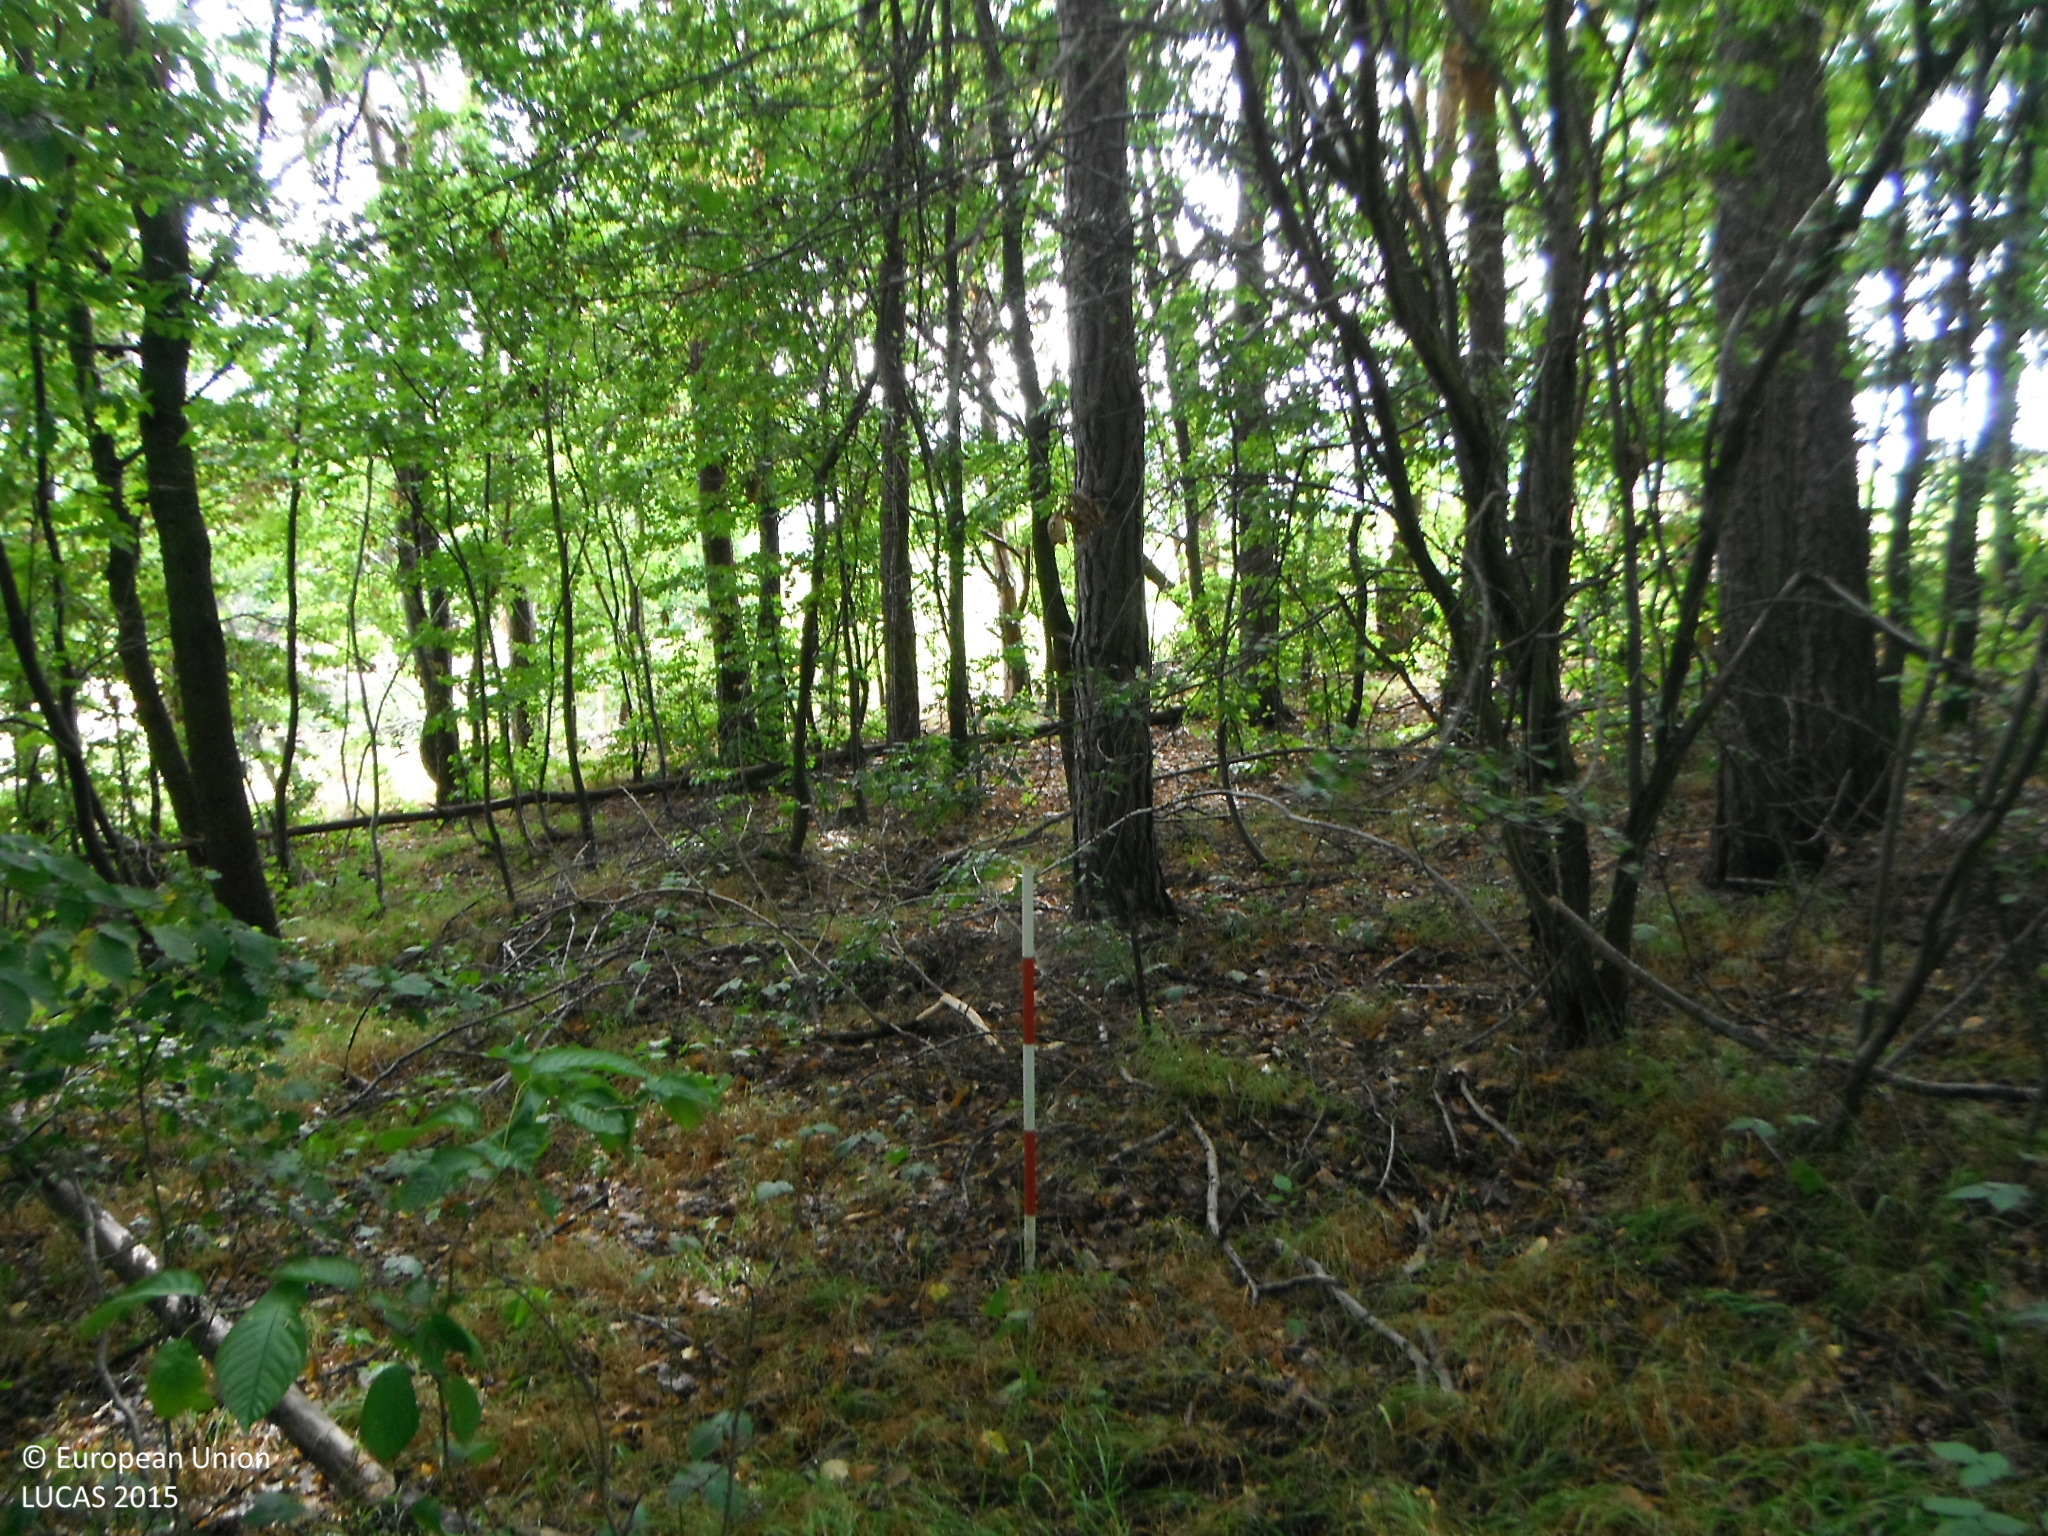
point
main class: Woodland
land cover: Other mixed woodland
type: hemiboreal forest and nemoral coniferous forest and mixed broadleaved-coniferous forest
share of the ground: > 75 %
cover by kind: coniferous forest trees 60 %, broadleaved forest trees 40 %
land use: Forestry
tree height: > 5 m
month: July
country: SK
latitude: 48.7582
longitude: 18.3276
